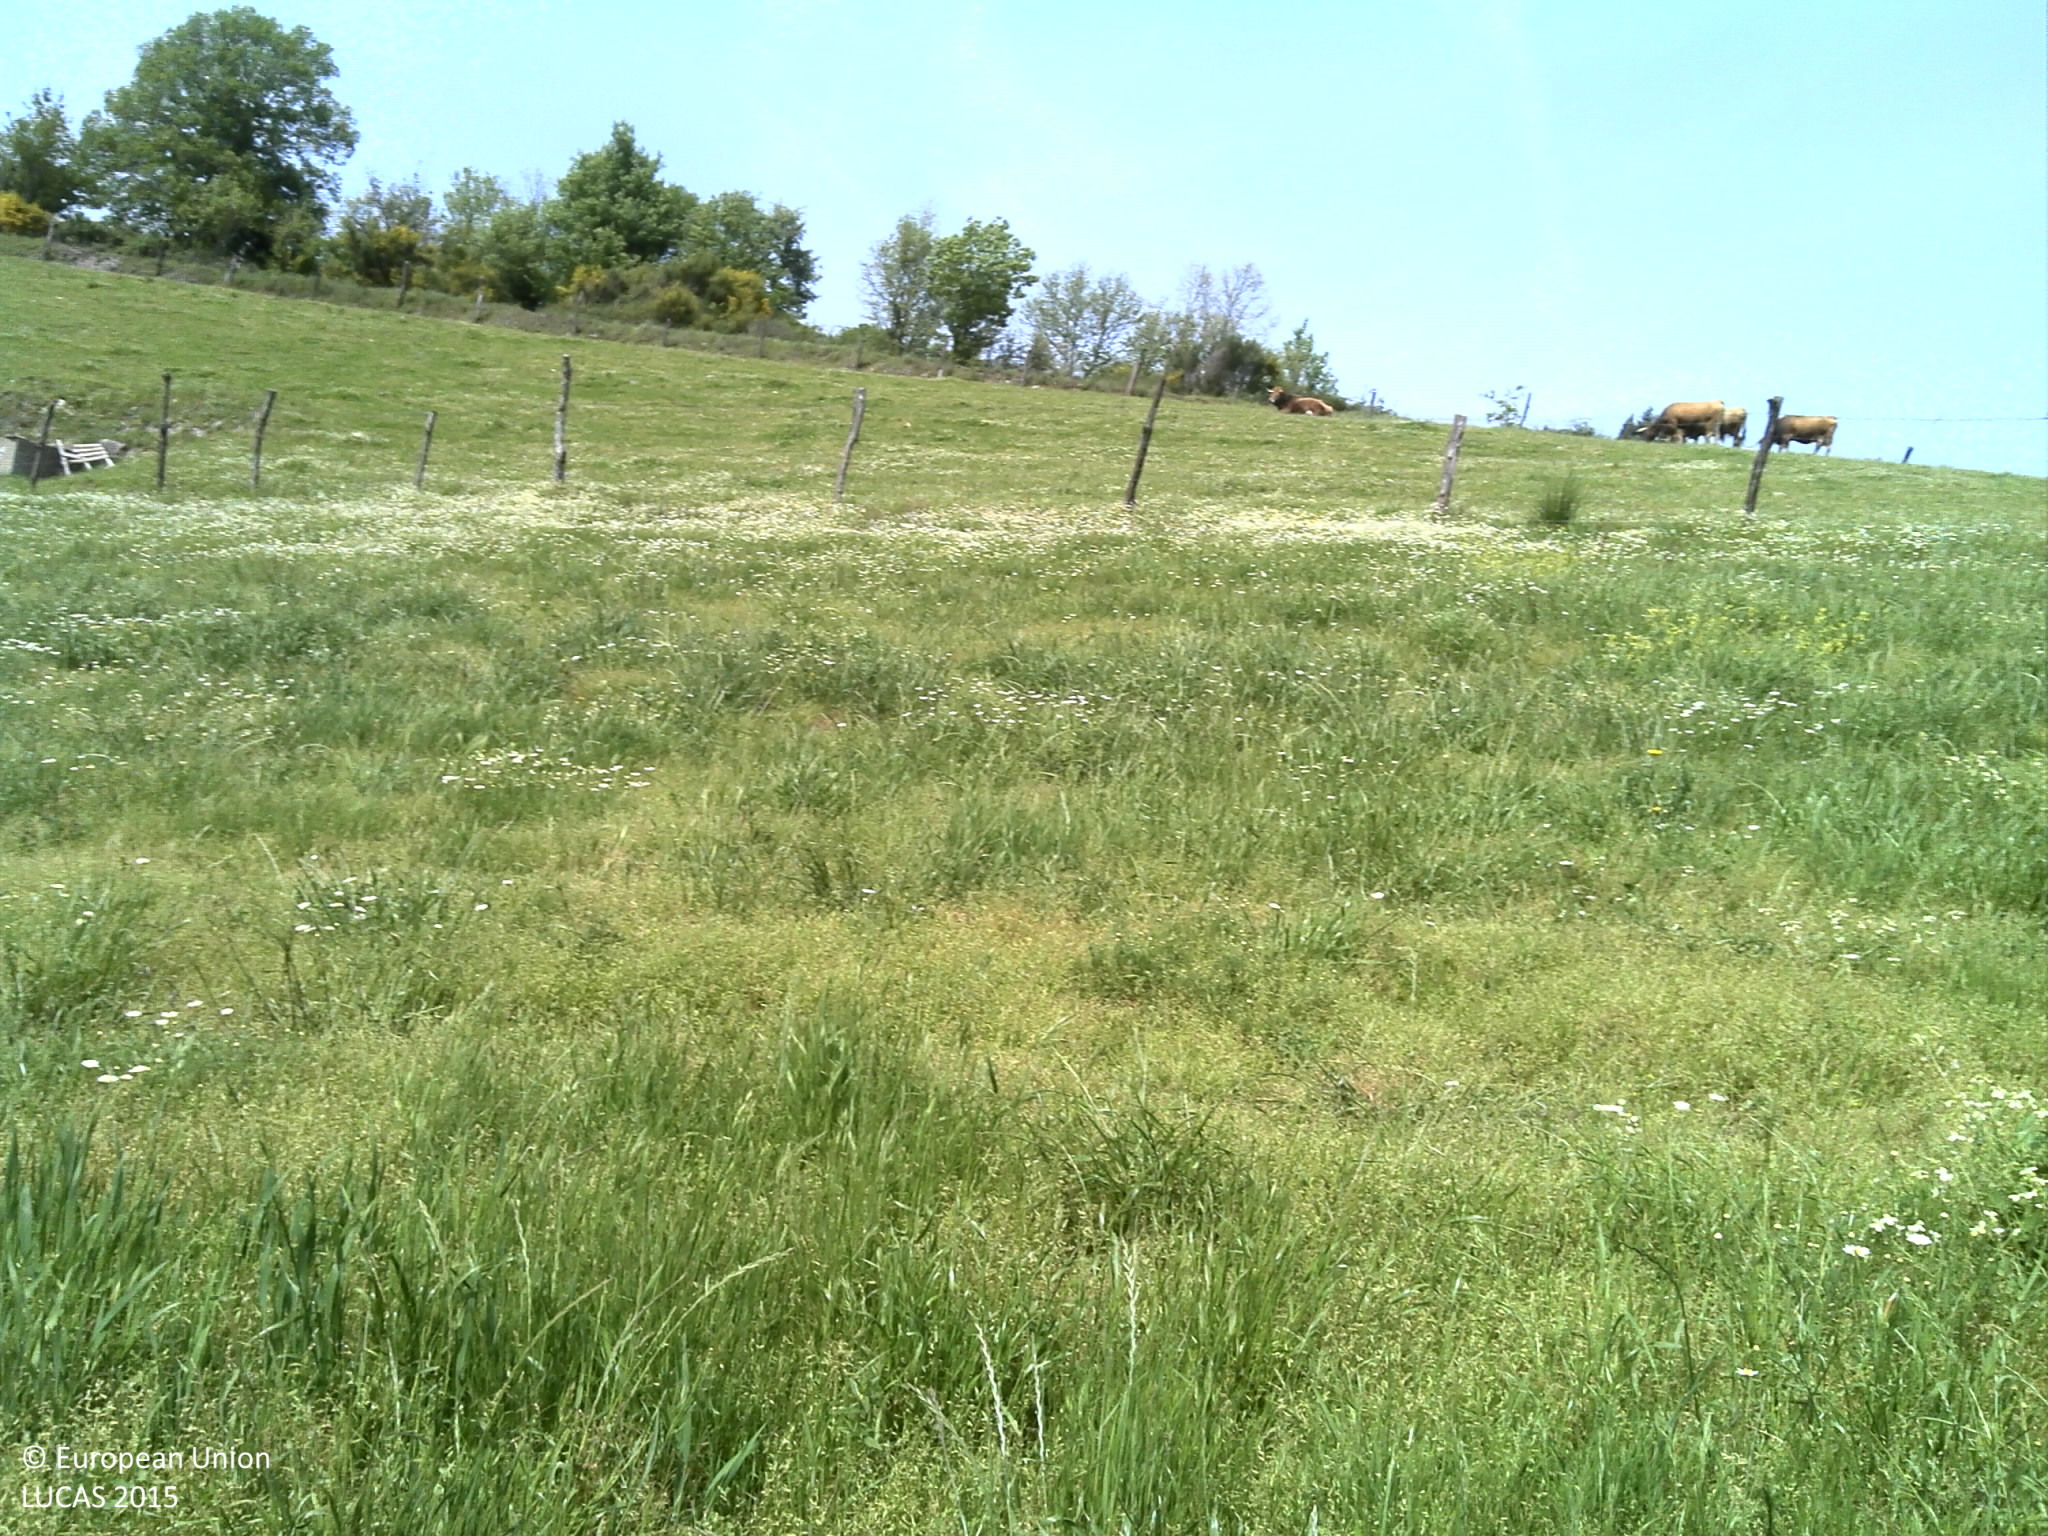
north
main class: Grassland
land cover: Spontaneously vegetated surfaces
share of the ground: > 75 %
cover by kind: herbaceous plants 95 %, unconsolidated bare surface 5 %
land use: Agriculture (excluding fallow land and kitchen gardens)
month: May
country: PT
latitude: 41.7623
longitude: -6.9691
